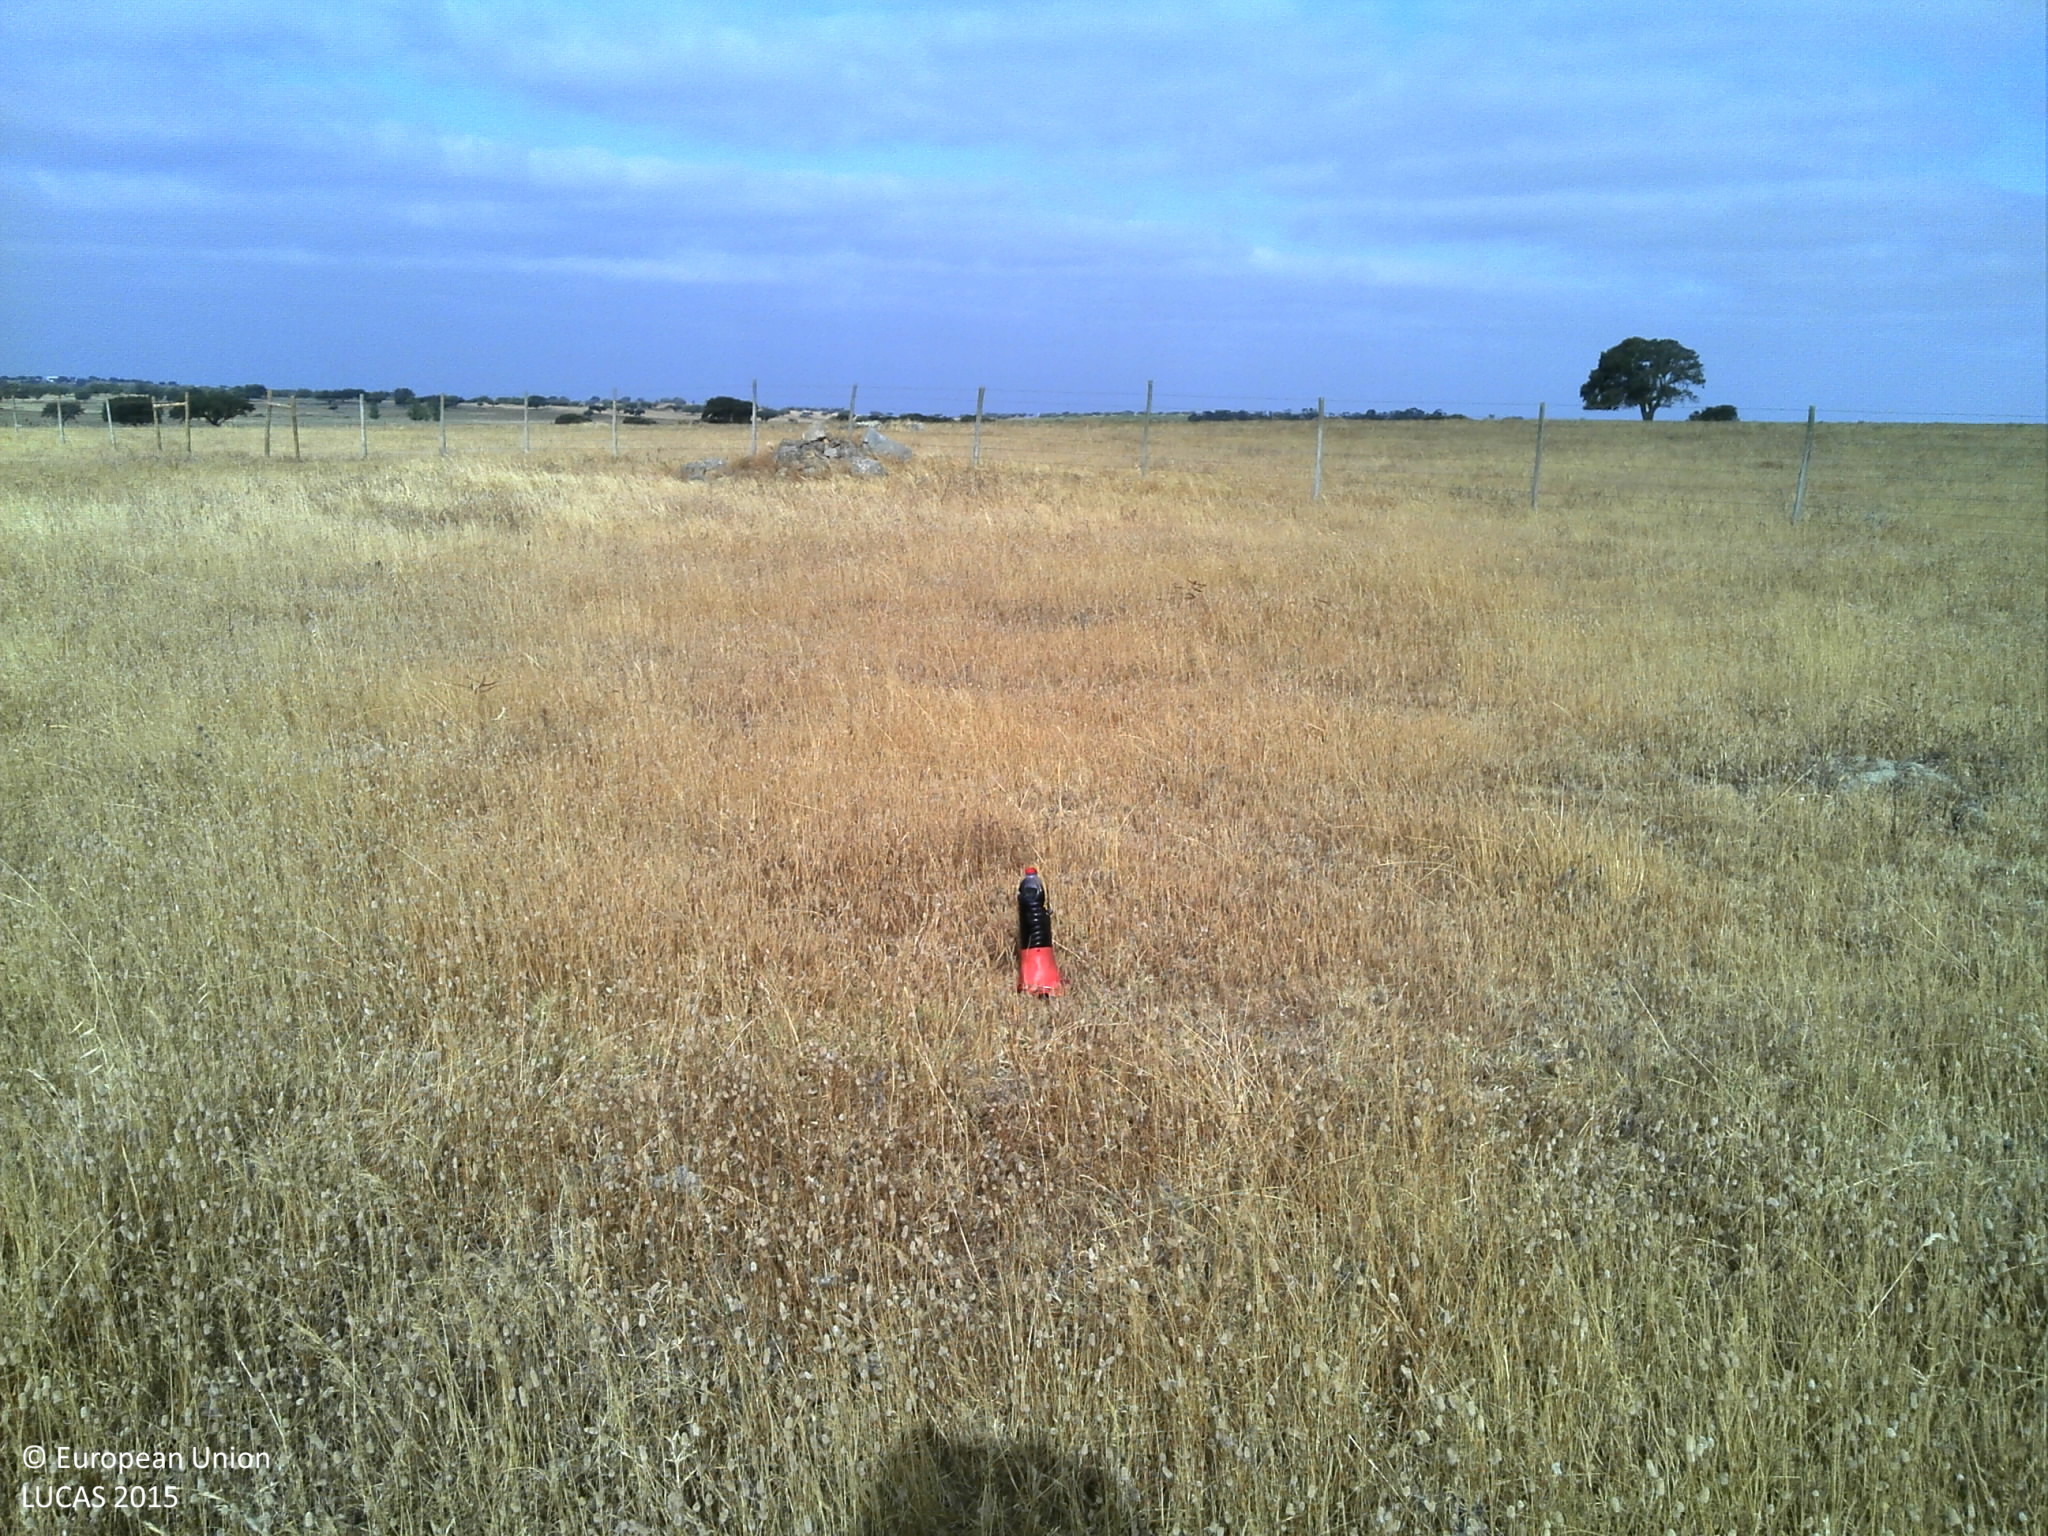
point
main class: Grassland
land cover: Grassland without tree/shrub cover
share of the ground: > 75 %
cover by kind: herbaceous plants 80 %, unconsolidated bare surface 20 %
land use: Agriculture (excluding fallow land and kitchen gardens)
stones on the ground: < 10 %
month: June
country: PT
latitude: 38.1769
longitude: -7.9202
